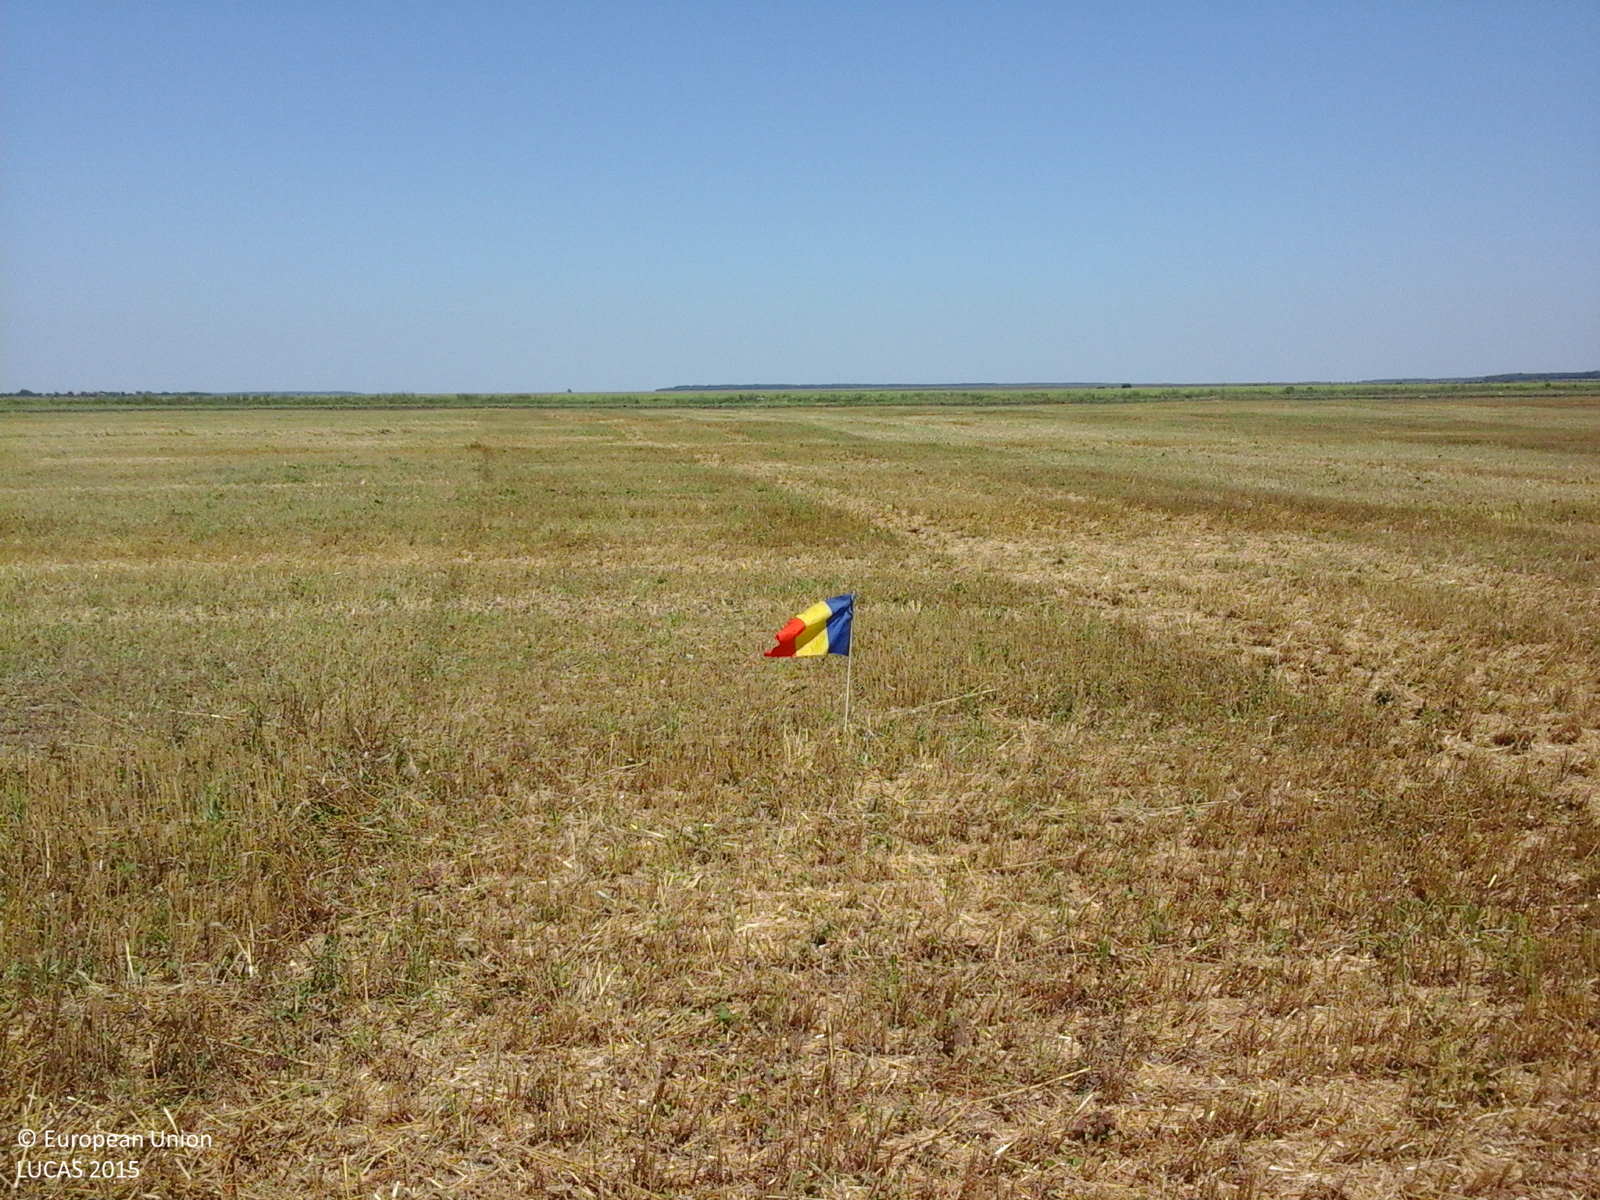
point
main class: Cropland
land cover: Common wheat
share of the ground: 10 - 25 %
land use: Agriculture (excluding fallow land and kitchen gardens)
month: July
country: RO
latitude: 44.3016
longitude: 26.5219
